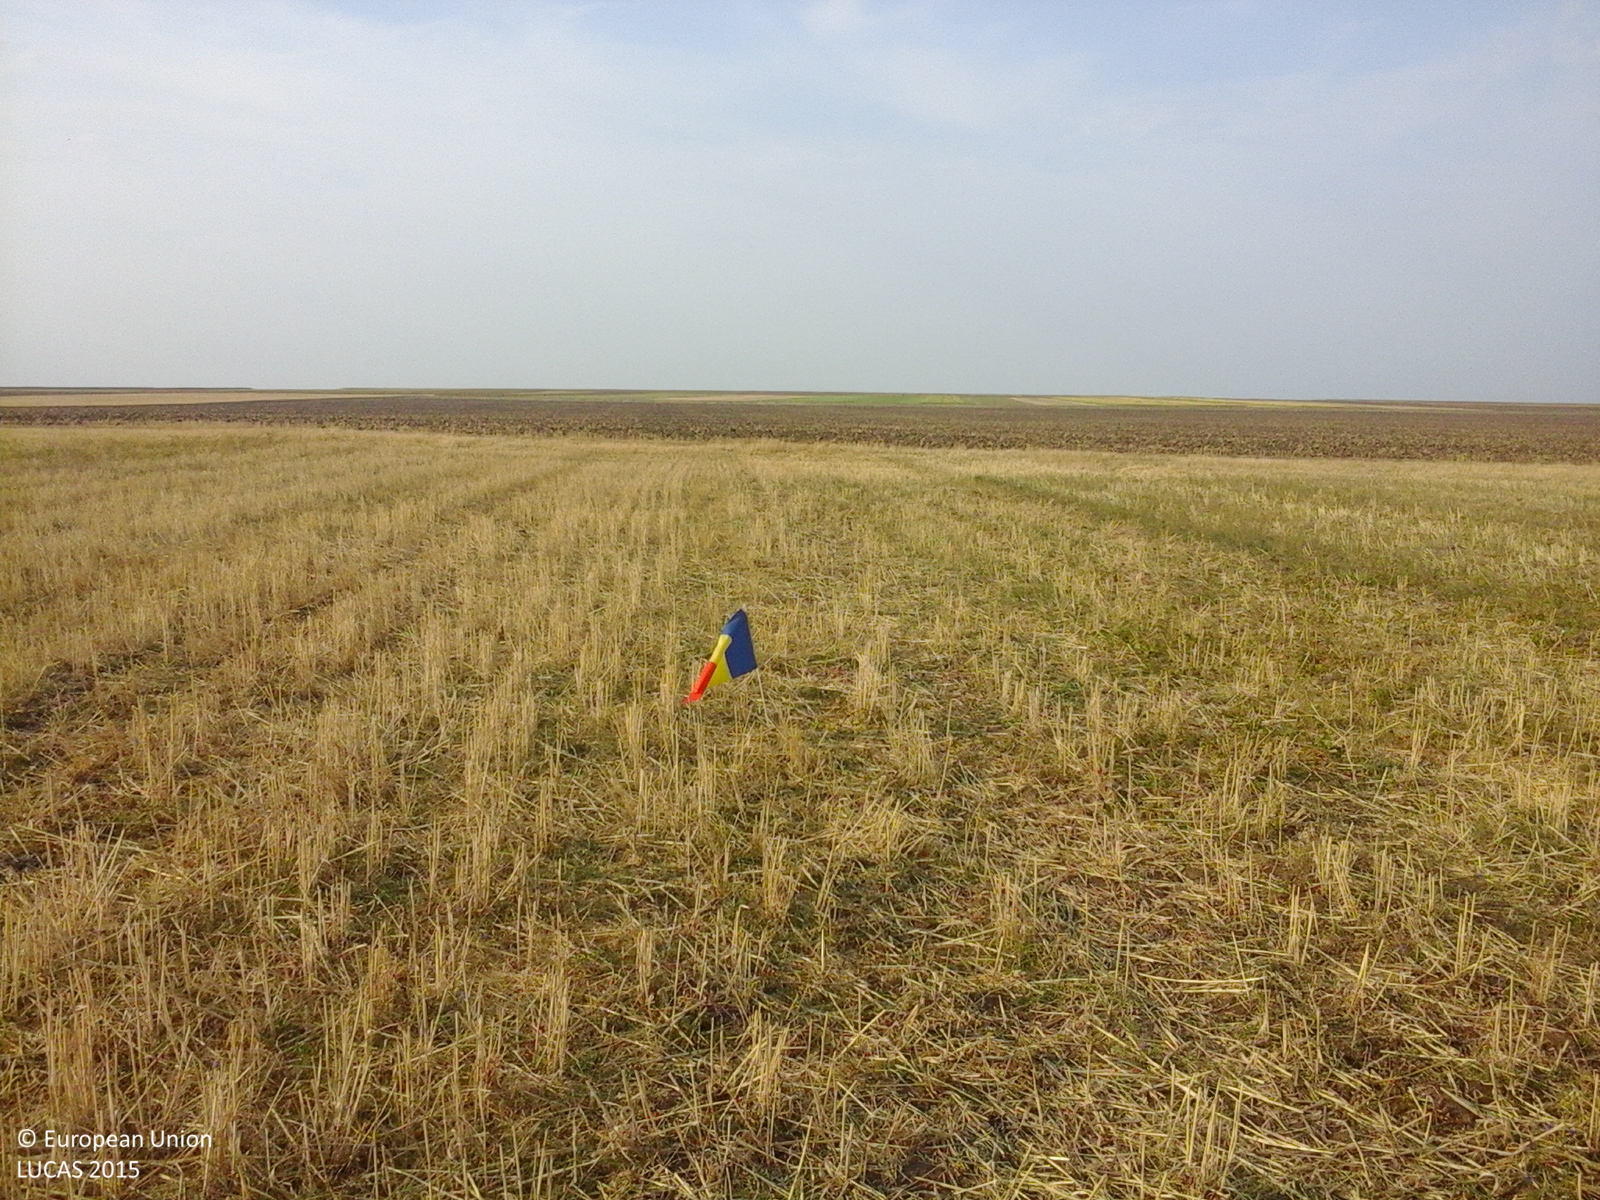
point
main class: Cropland
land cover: Common wheat
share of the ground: 25 - 50 %
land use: Agriculture (excluding fallow land and kitchen gardens)
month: August
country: RO
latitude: 44.2454
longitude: 23.1061
